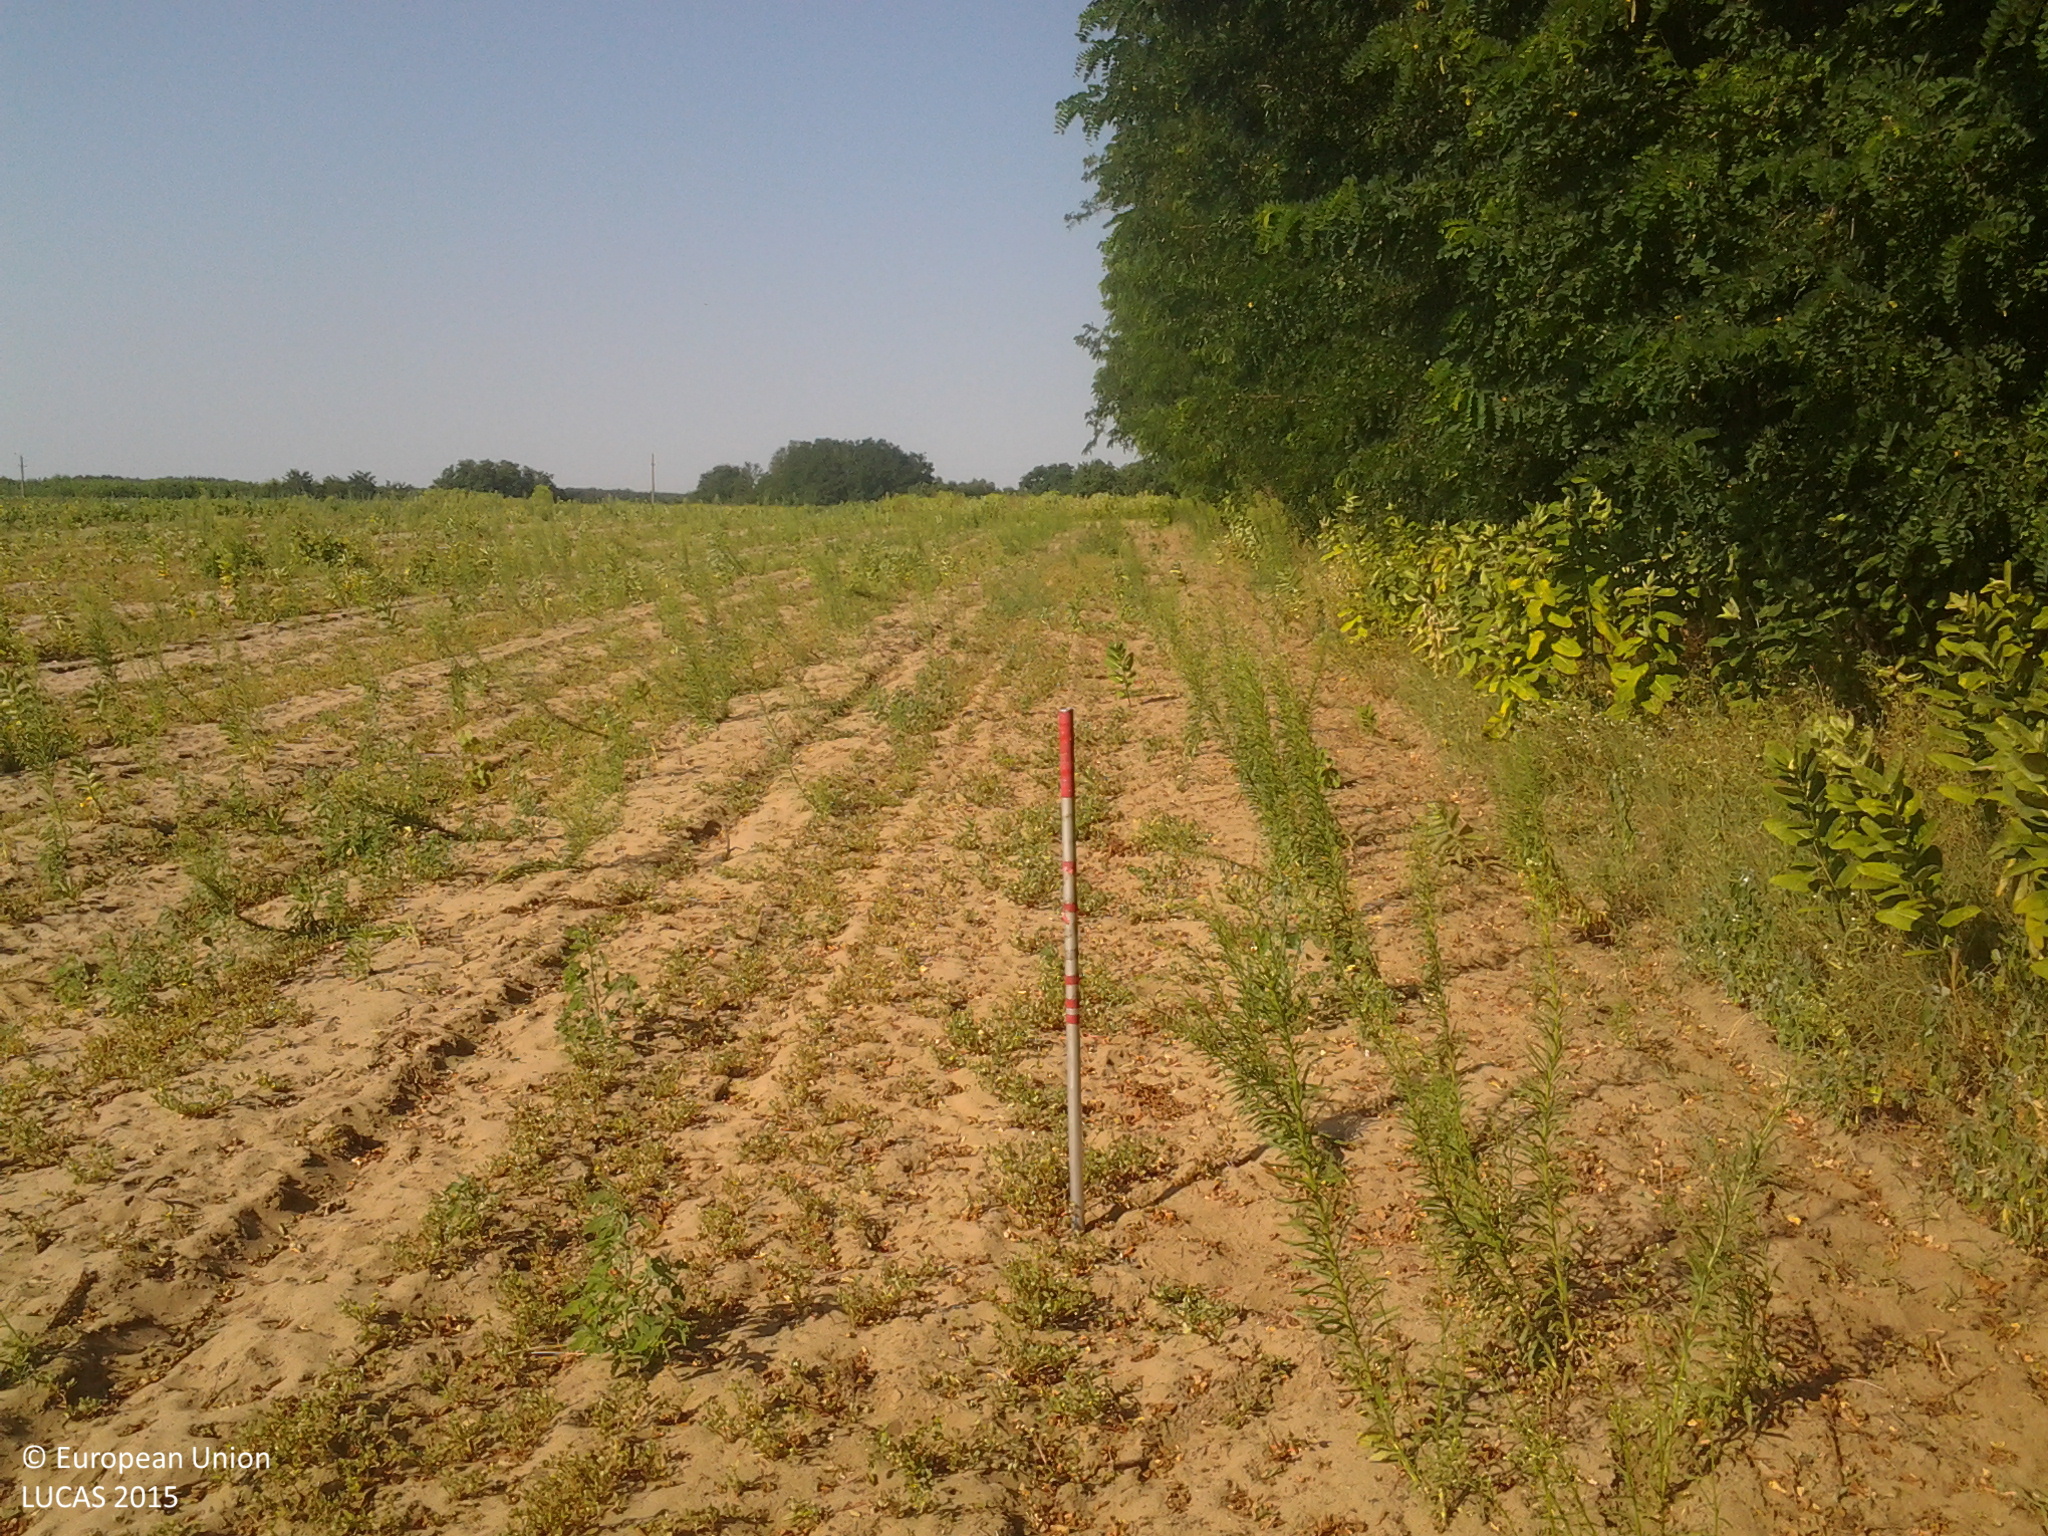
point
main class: Grassland
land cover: Spontaneously vegetated surfaces
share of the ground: 50 - 75 %
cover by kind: herbaceous plants 65 %, unconsolidated bare surface 35 %
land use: Forestry
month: July
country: HU
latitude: 46.5132
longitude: 19.2300
